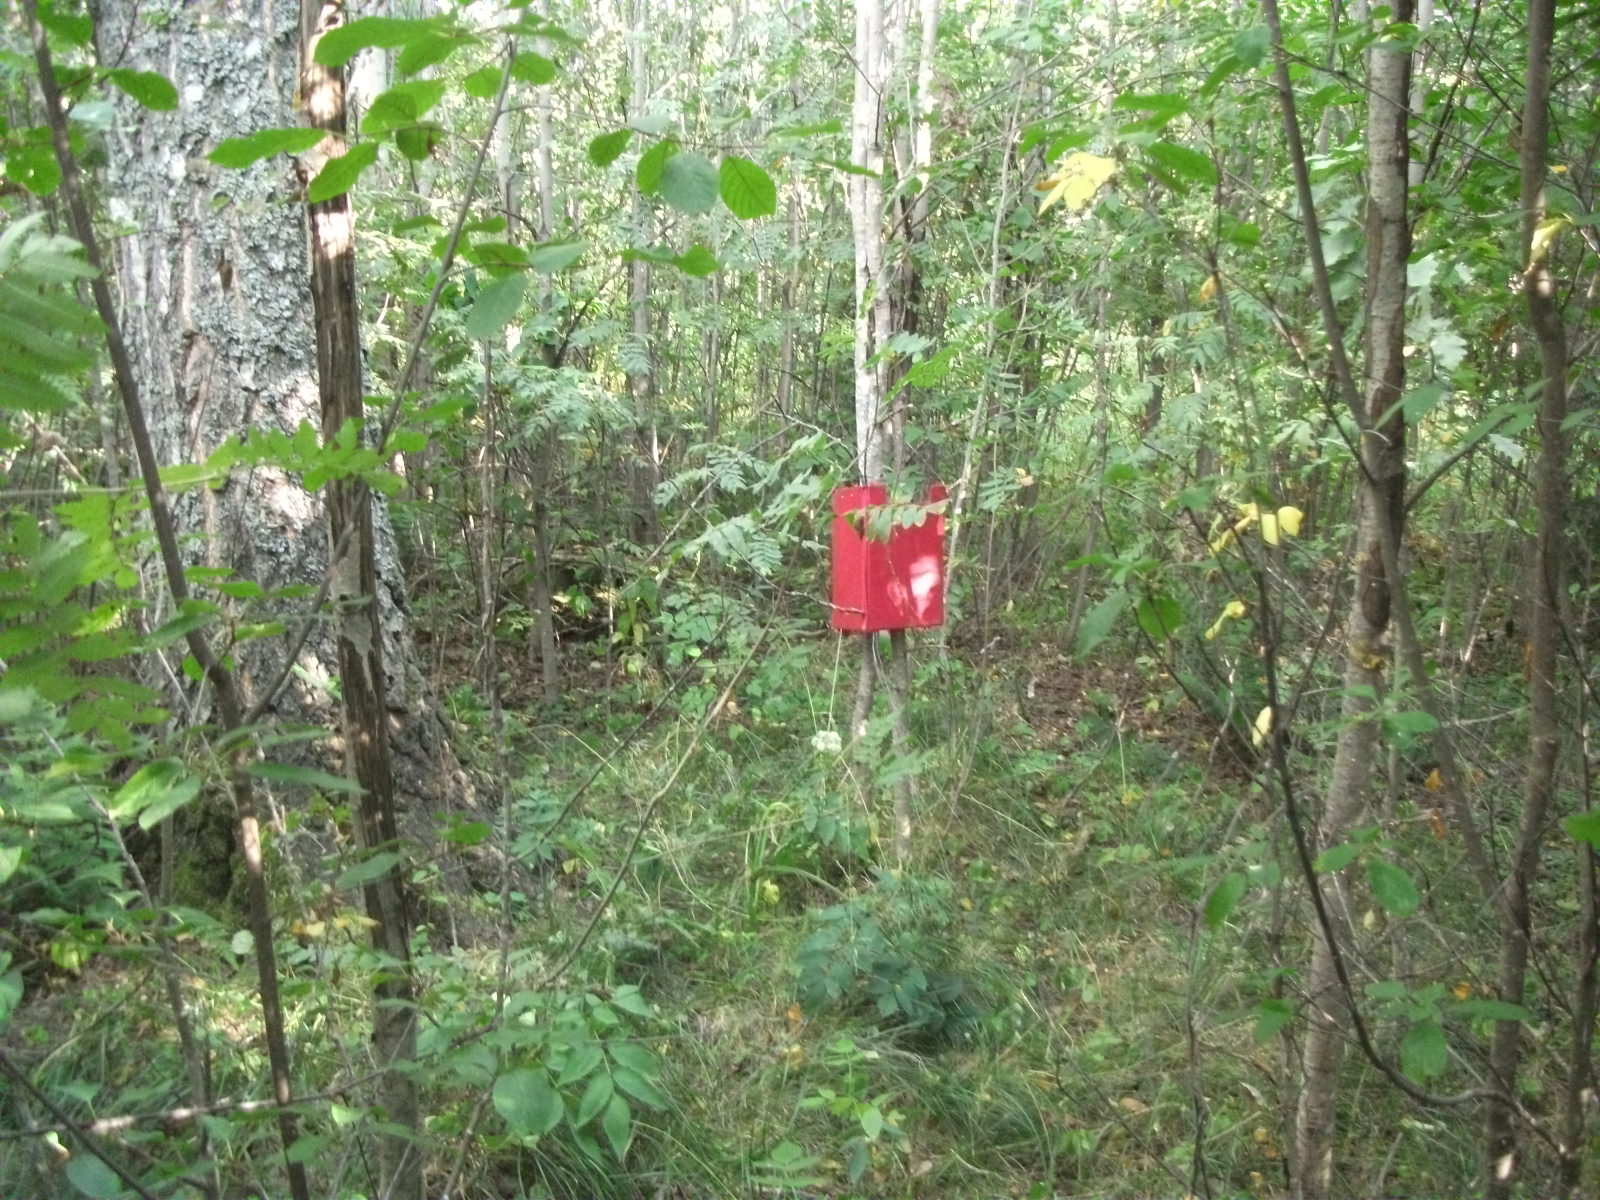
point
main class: Woodland
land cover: Broadleaved woodland
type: non-riverine alder, birch or aspen forest
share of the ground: > 75 %
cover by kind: broadleaved forest trees 90 %, shrubs 10 %
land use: Forestry
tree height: > 5 m
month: August
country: LV
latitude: 56.3827
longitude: 26.3224
